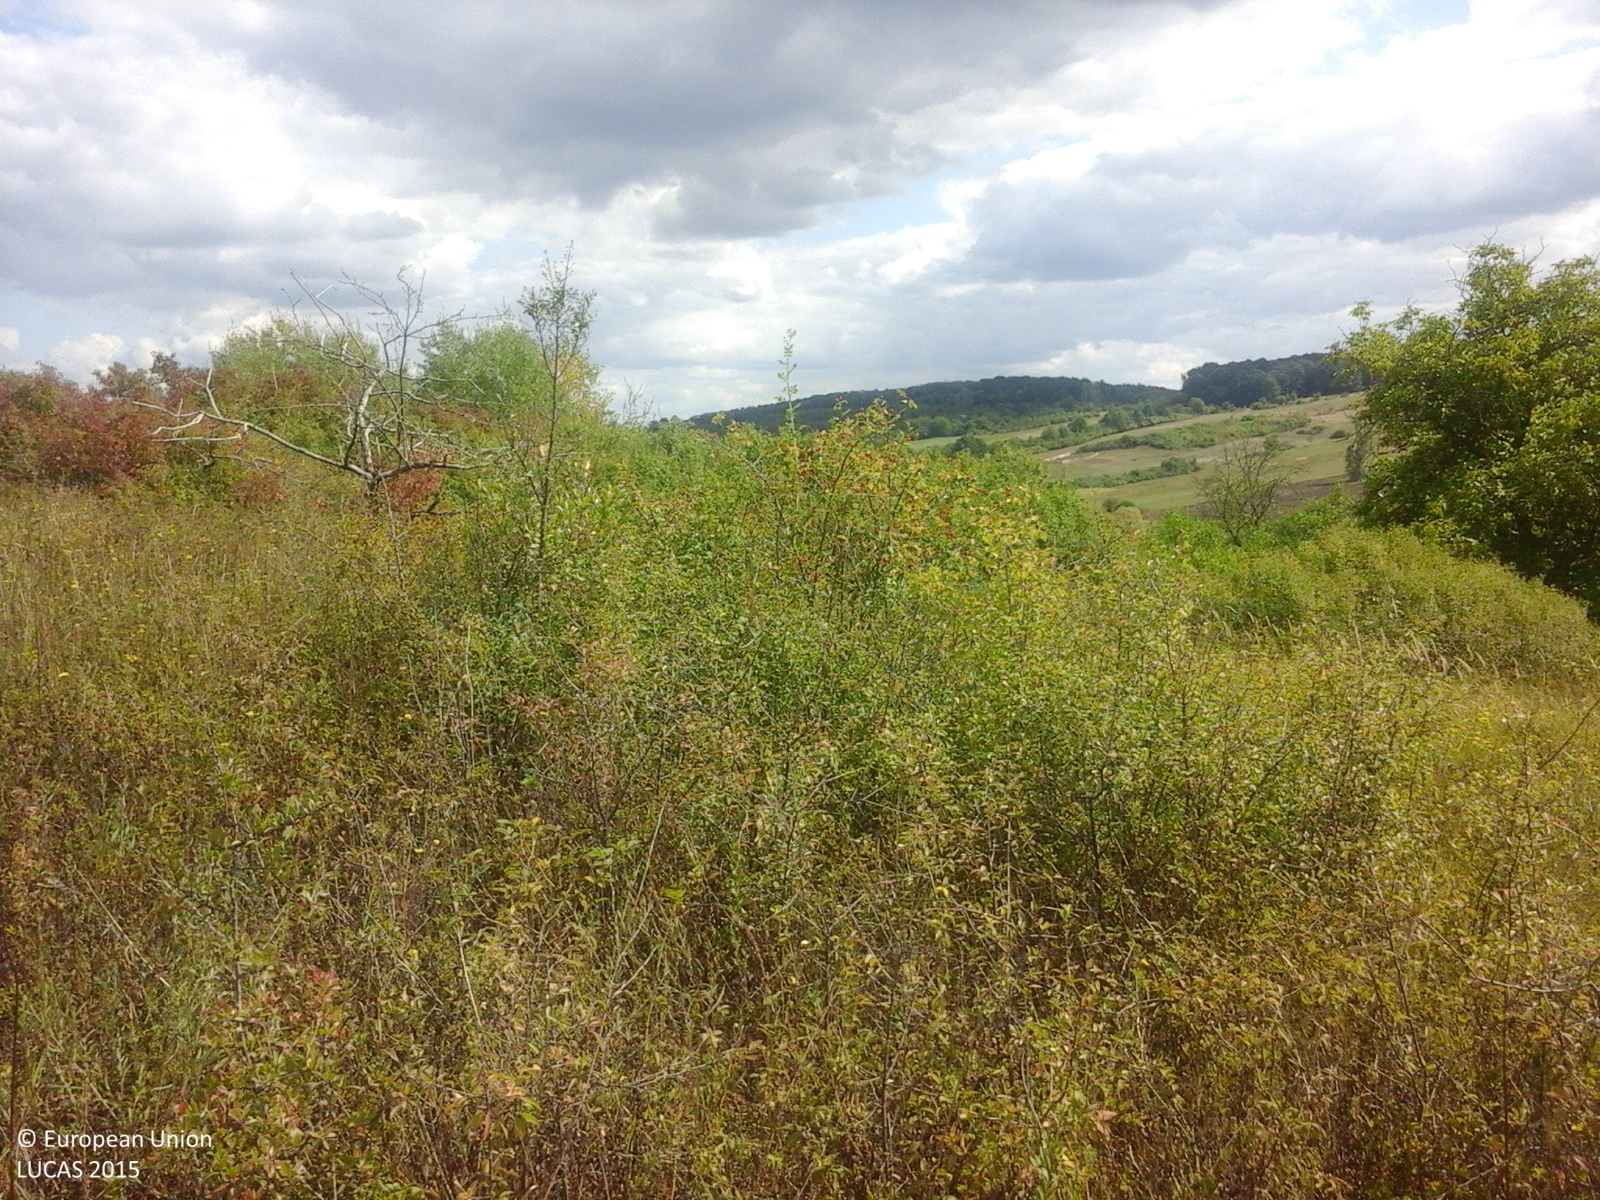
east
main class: Grassland
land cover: Spontaneously vegetated surfaces
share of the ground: > 75 %
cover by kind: herbaceous plants 100 %
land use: Fallow land
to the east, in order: Spontaneously vegetated surfaces; Shrubland without tree cover; Shrubland with sparse tree cover; Shrubland without tree cover; Common wheat; Spontaneously vegetated surfaces; Vineyards
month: September
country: RO
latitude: 47.4585
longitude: 23.0789
